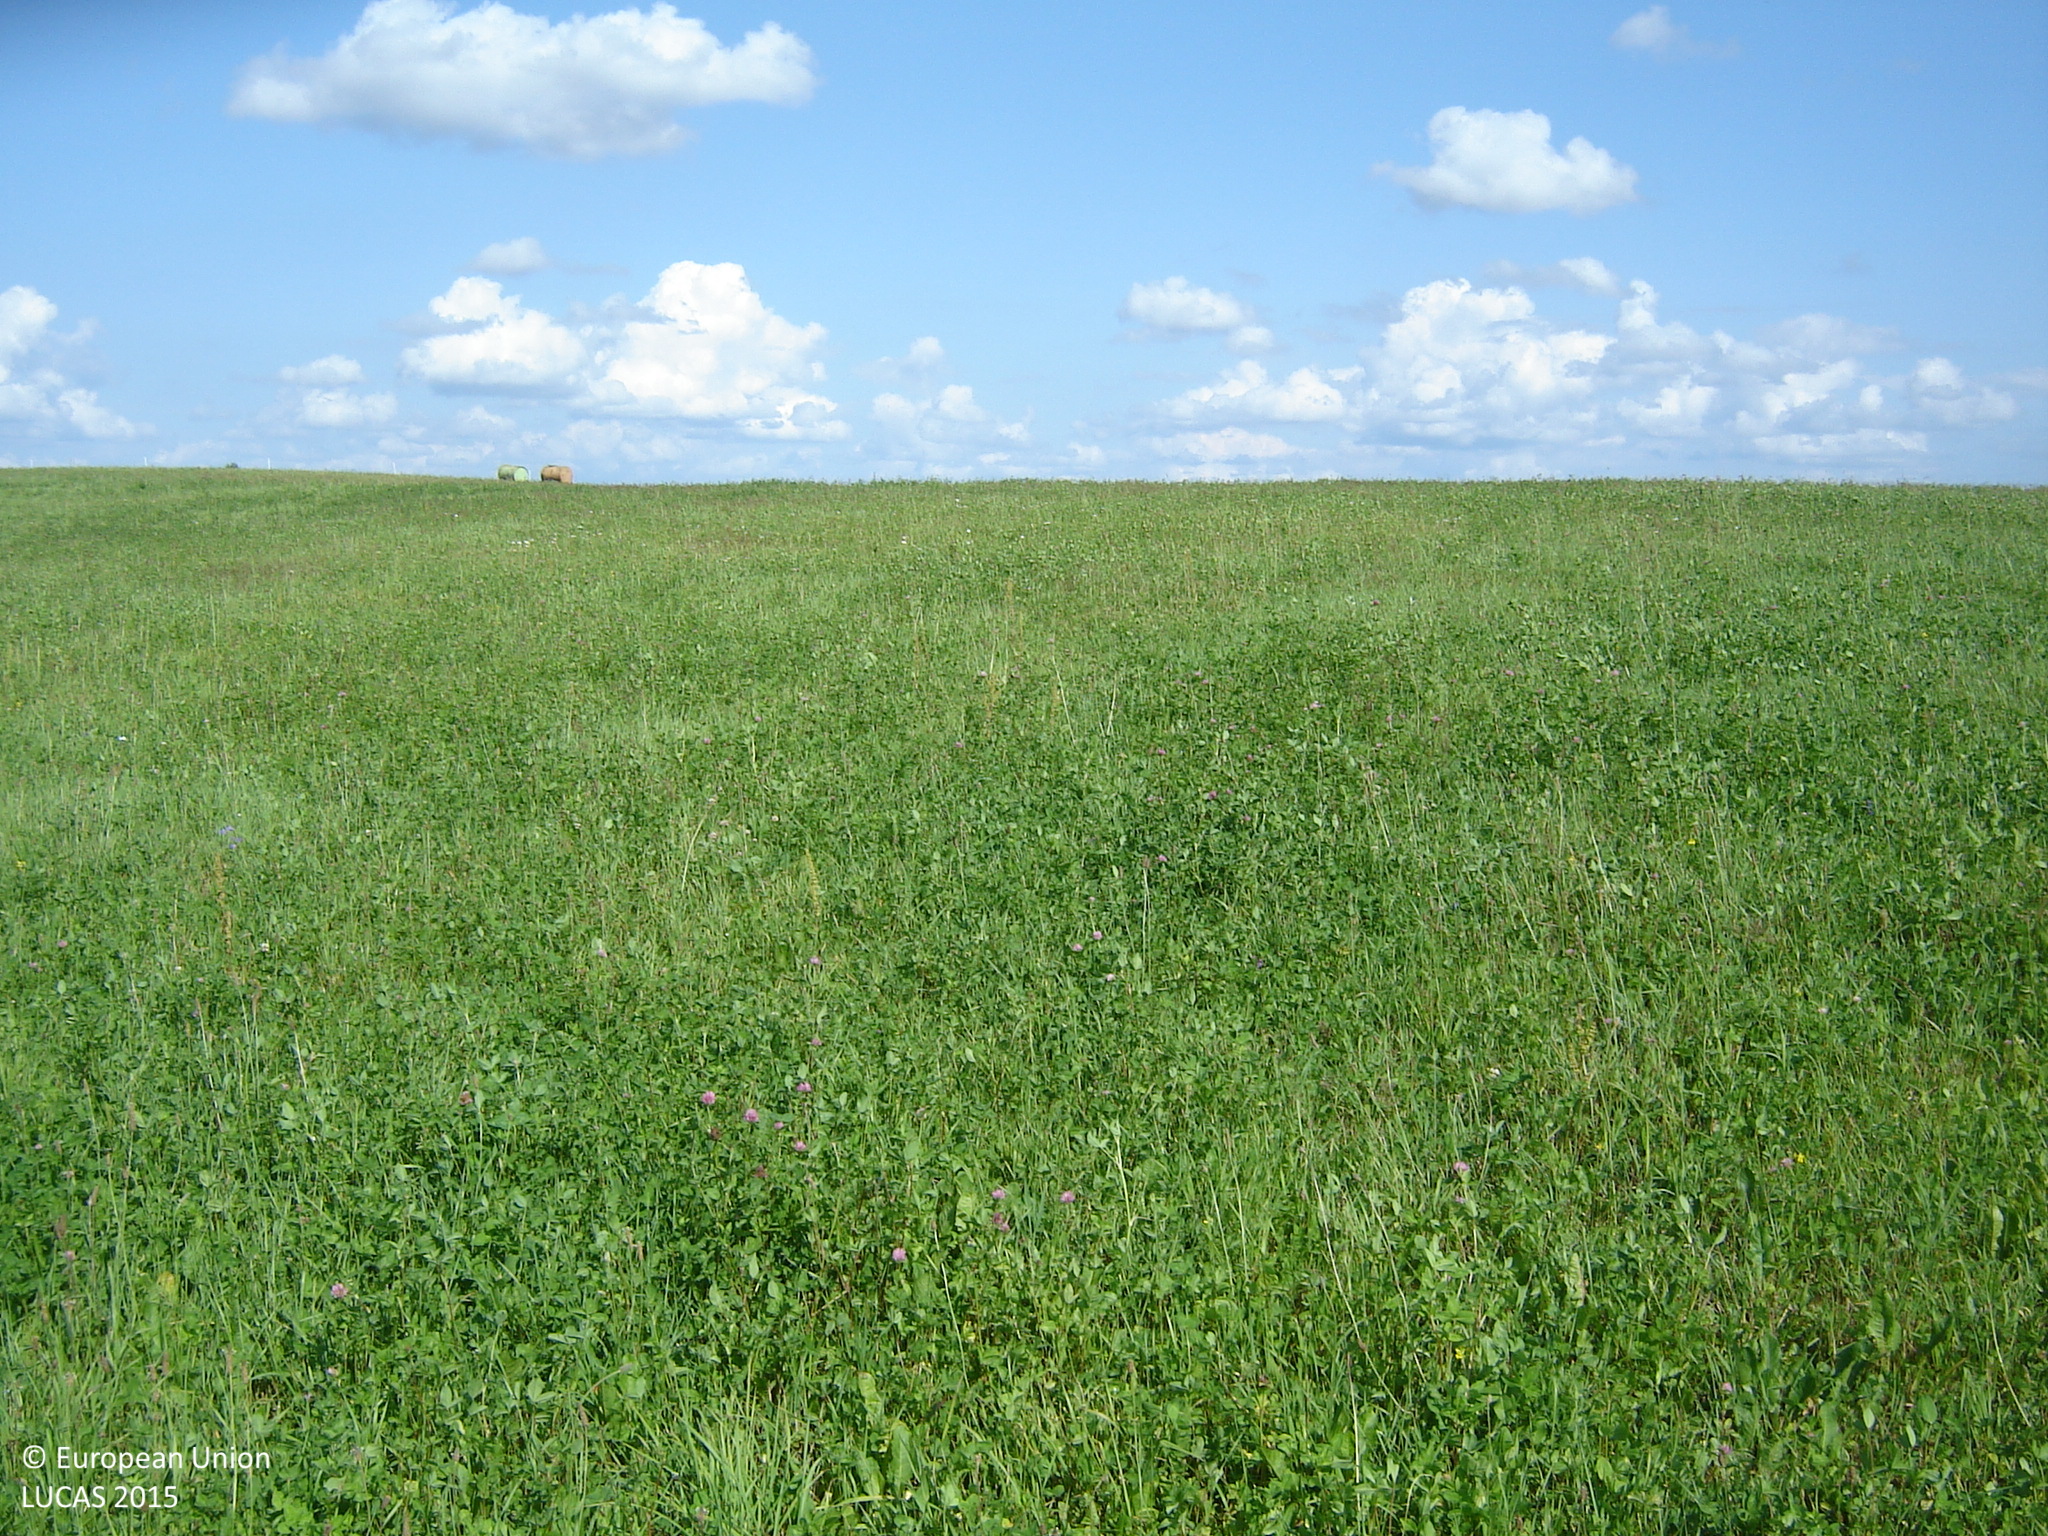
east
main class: Grassland
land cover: Grassland without tree/shrub cover
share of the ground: > 75 %
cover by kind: herbaceous plants 100 %
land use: Agriculture (excluding fallow land and kitchen gardens)
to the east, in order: Grassland without tree/shrub cover; Fences; Grassland without tree/shrub cover
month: July
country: LT
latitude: 55.4905
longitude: 25.2323
